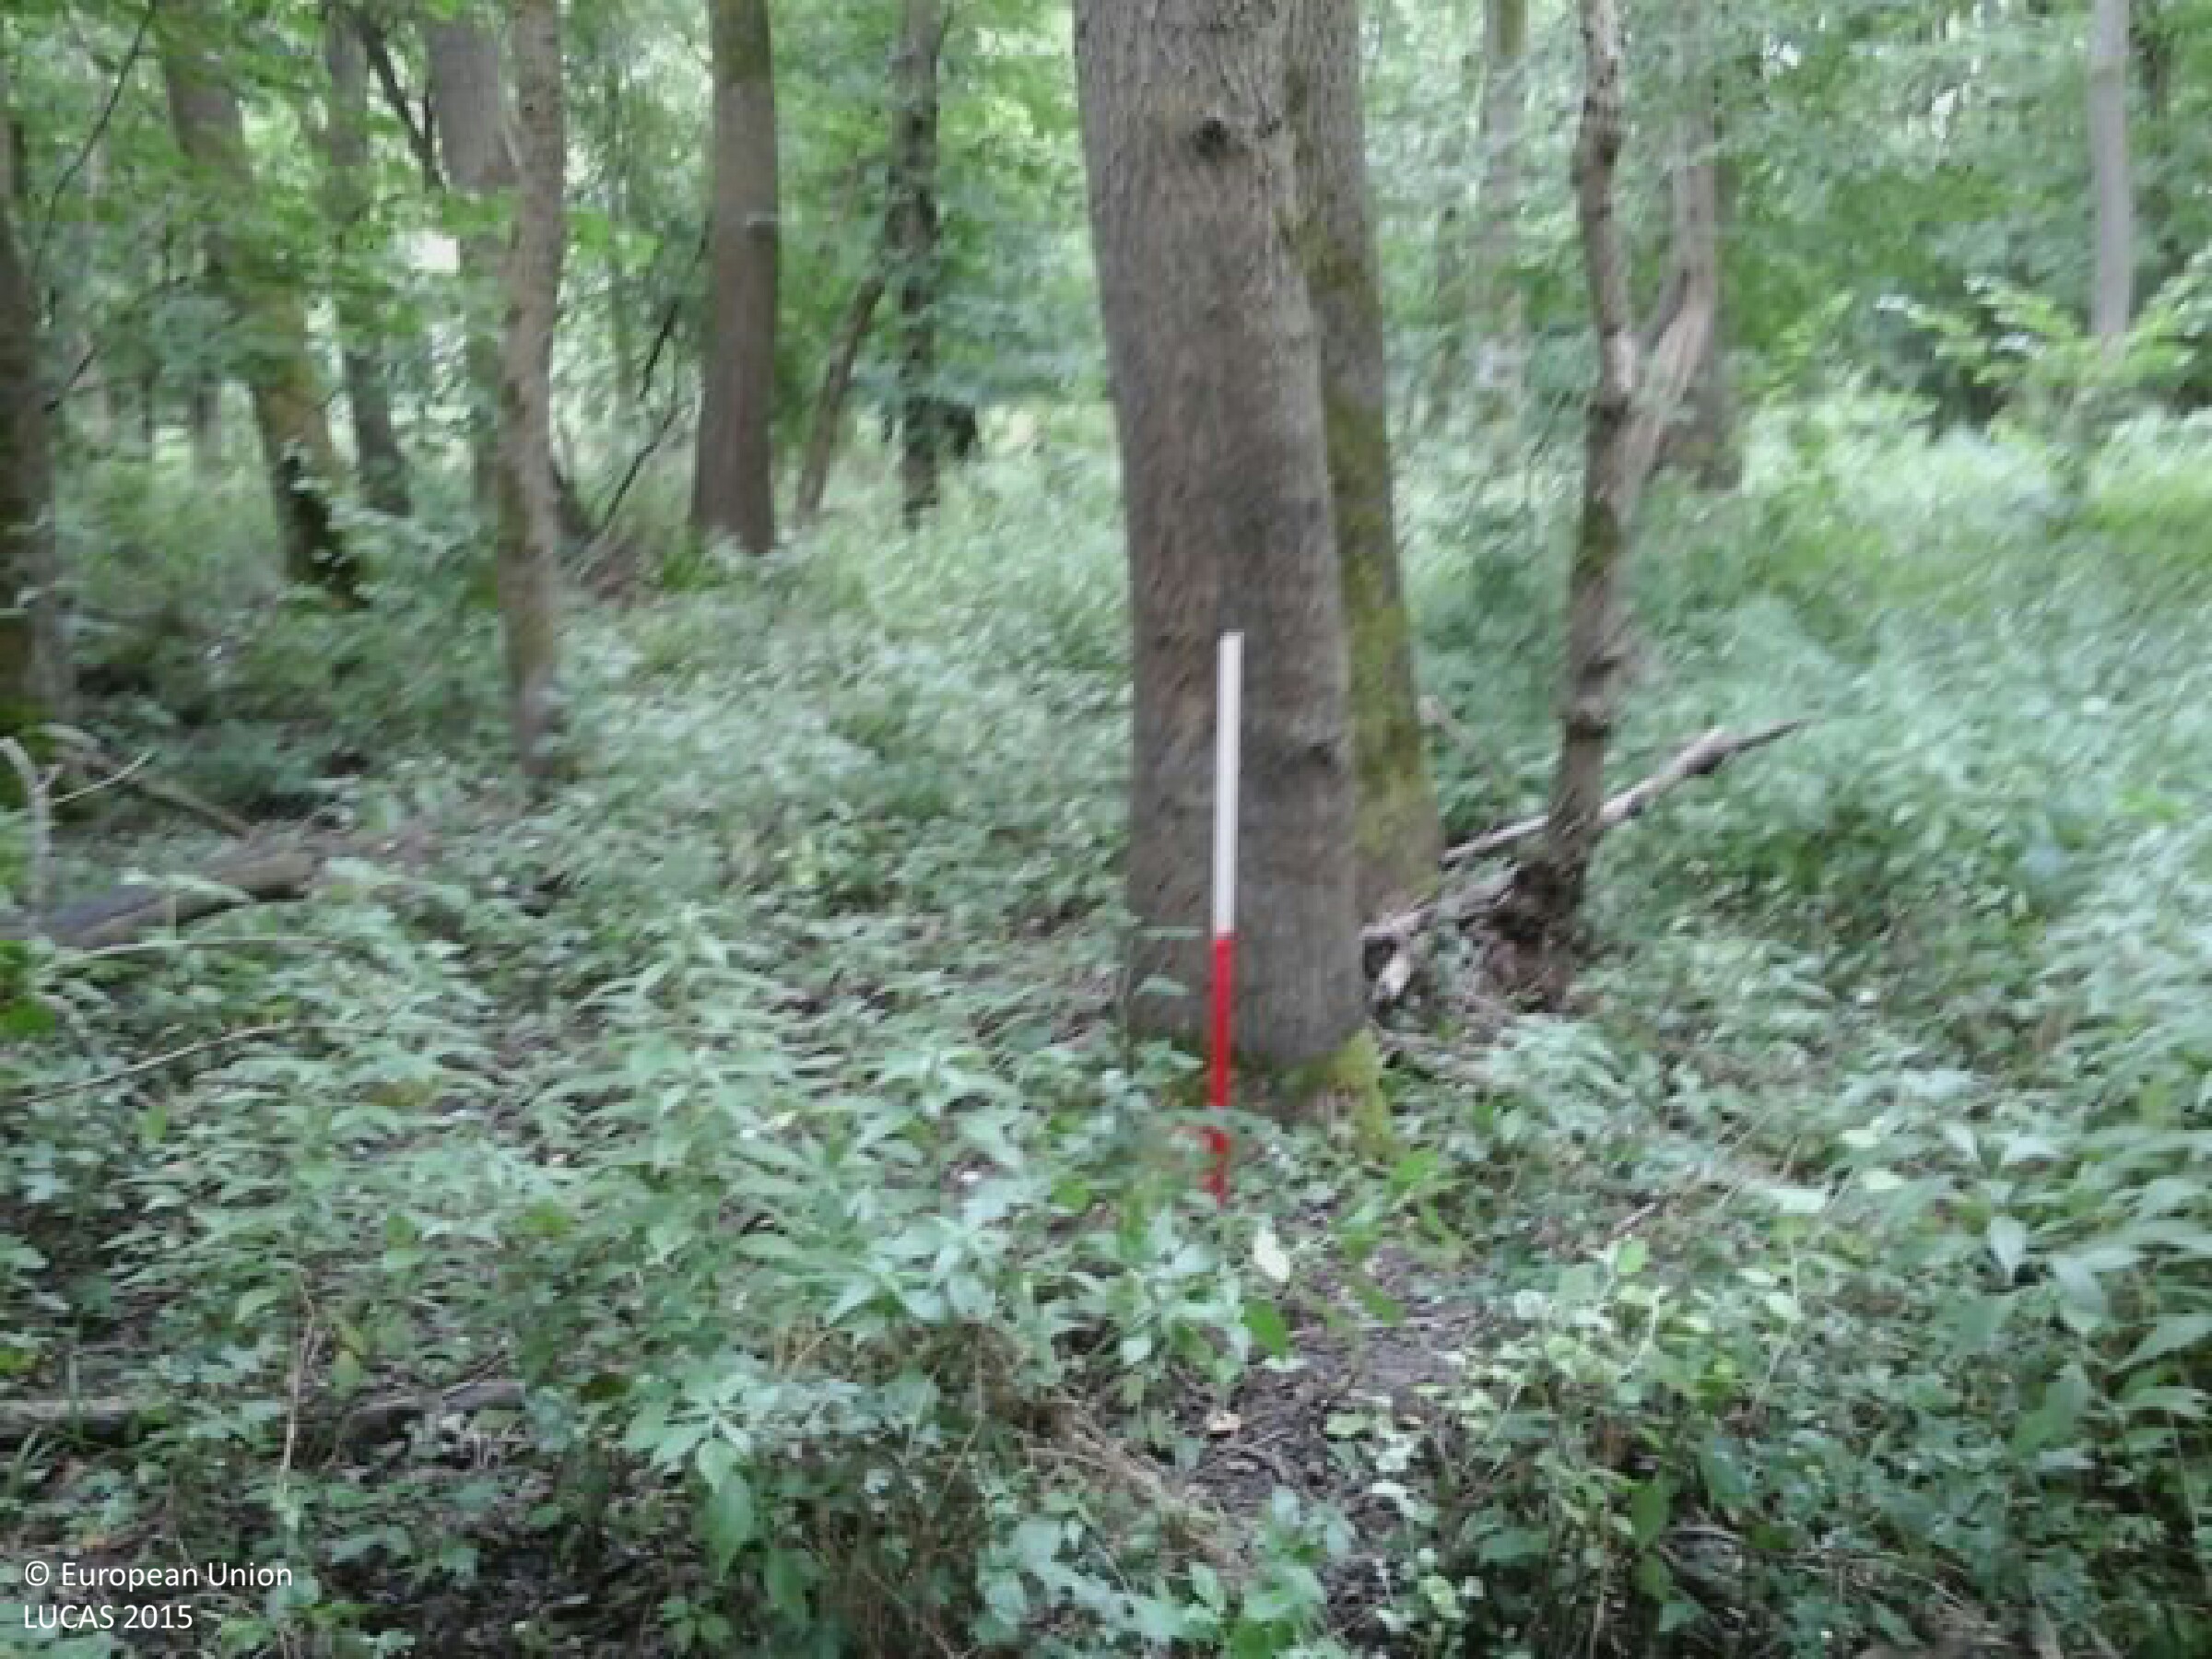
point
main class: Woodland
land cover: Broadleaved woodland
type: mesophytic deciduous forest
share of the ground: 50 - 75 %
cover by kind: broadleaved forest trees 65 %, herbaceous plants 20 %, shrubs 15 %
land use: Forestry
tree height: > 5 m
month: July
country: HU
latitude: 46.3095
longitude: 18.8547
